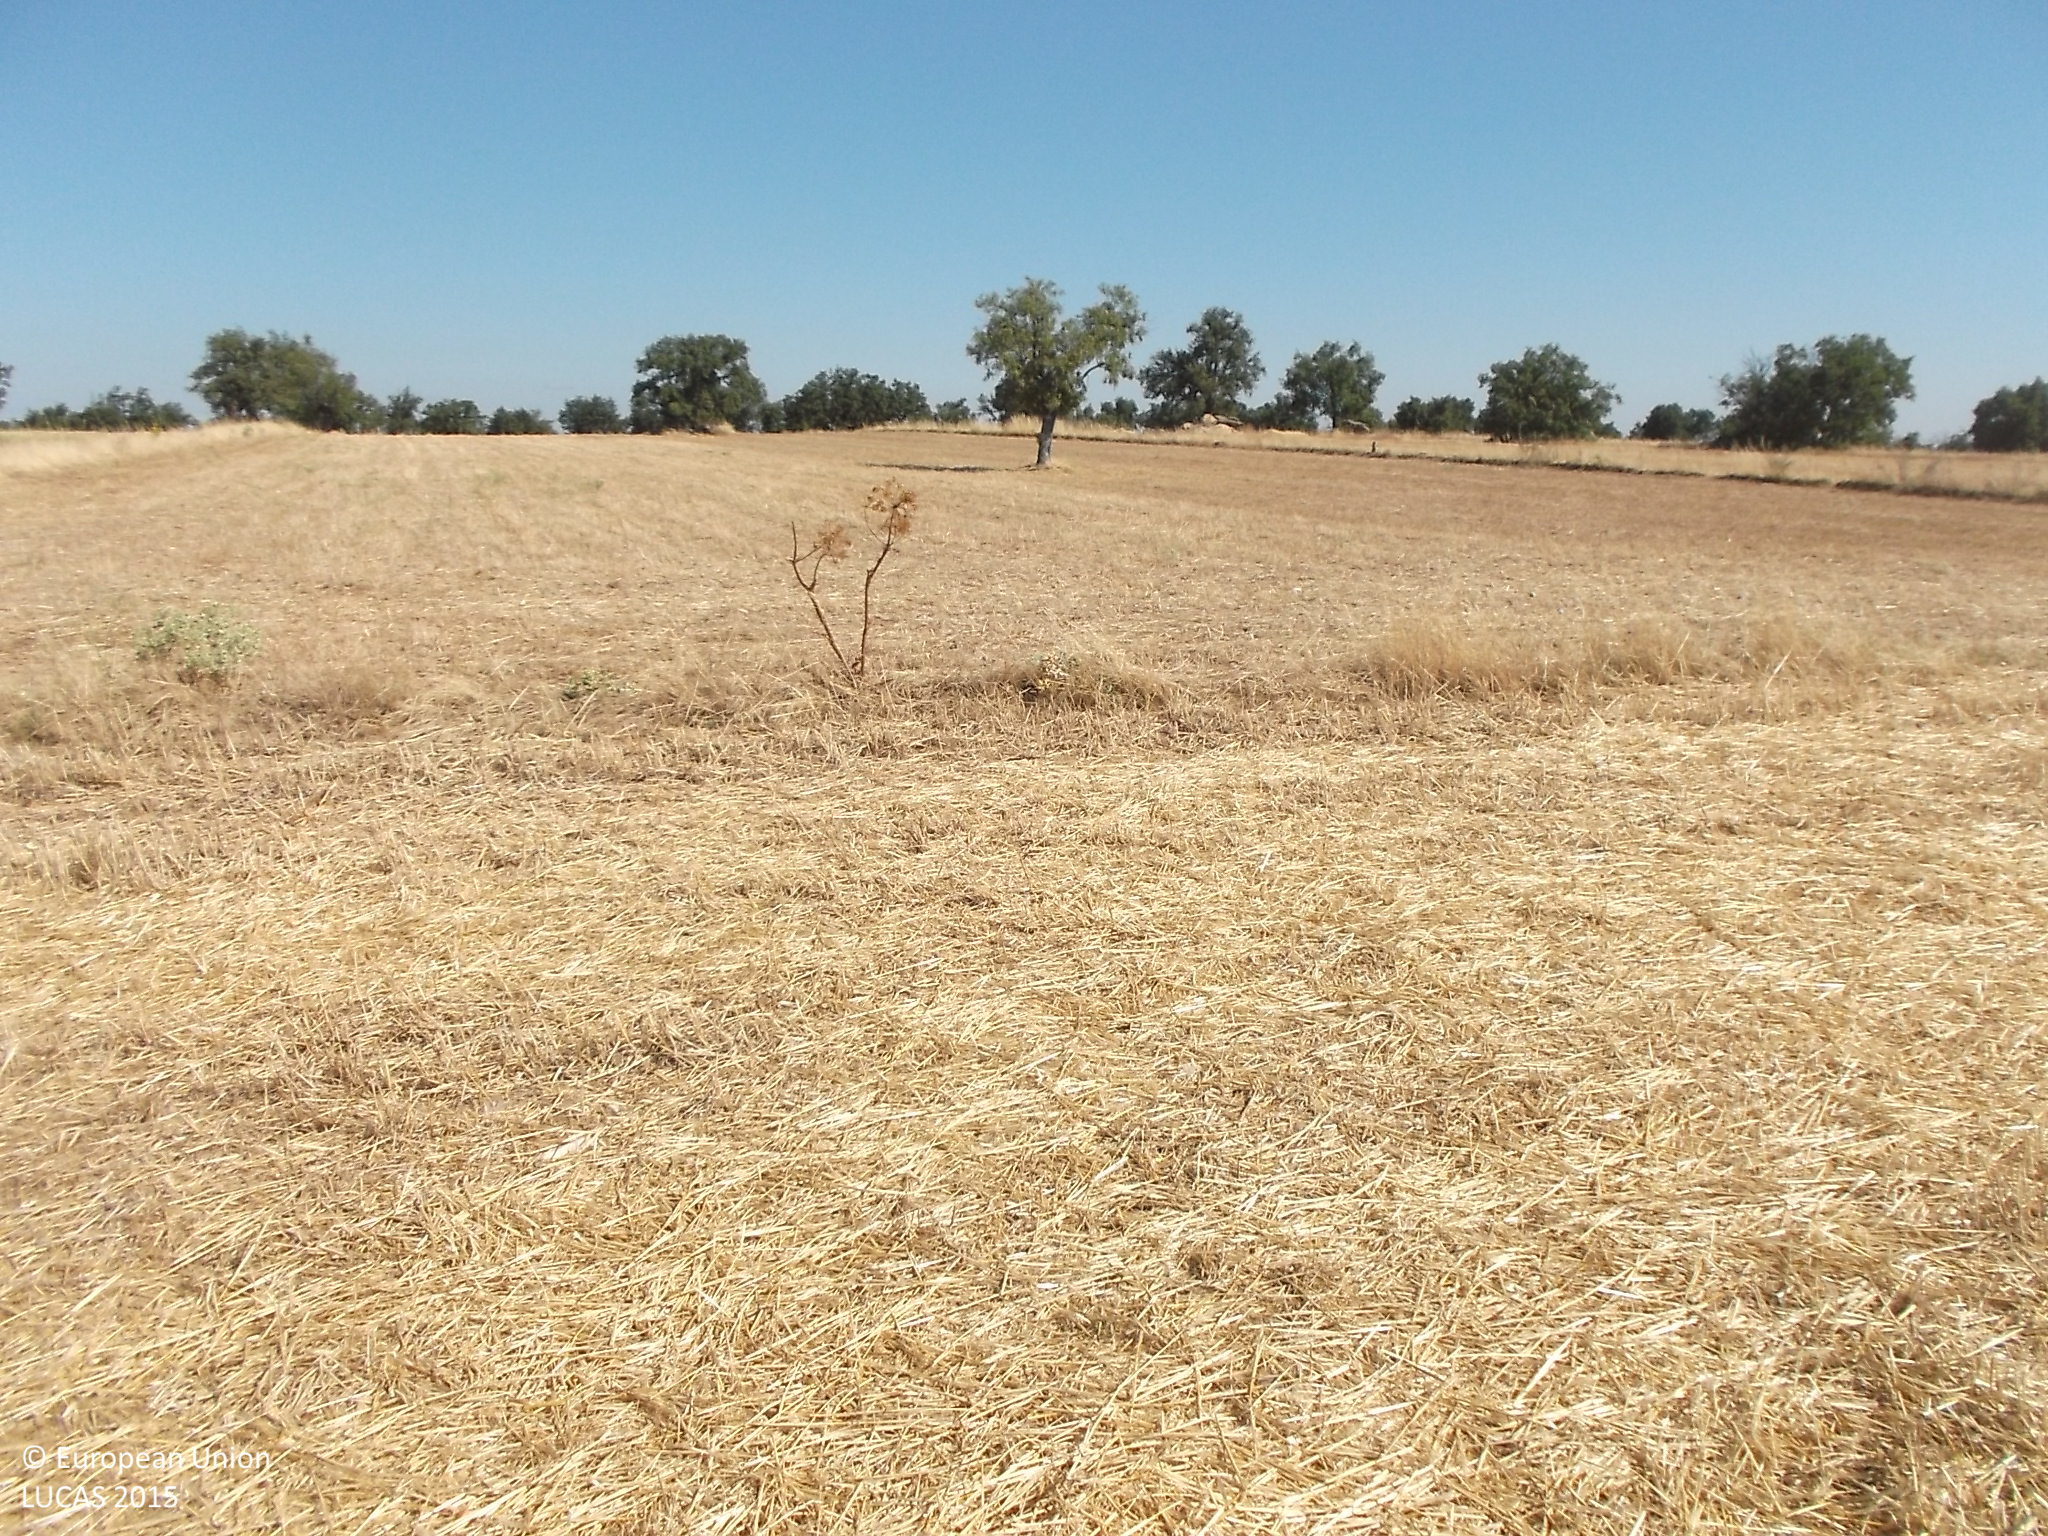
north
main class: Cropland
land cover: Barley
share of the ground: < 10 %
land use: Agriculture (excluding fallow land and kitchen gardens)
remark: Harvested field
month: July
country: ES
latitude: 41.3681
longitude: -6.0267
